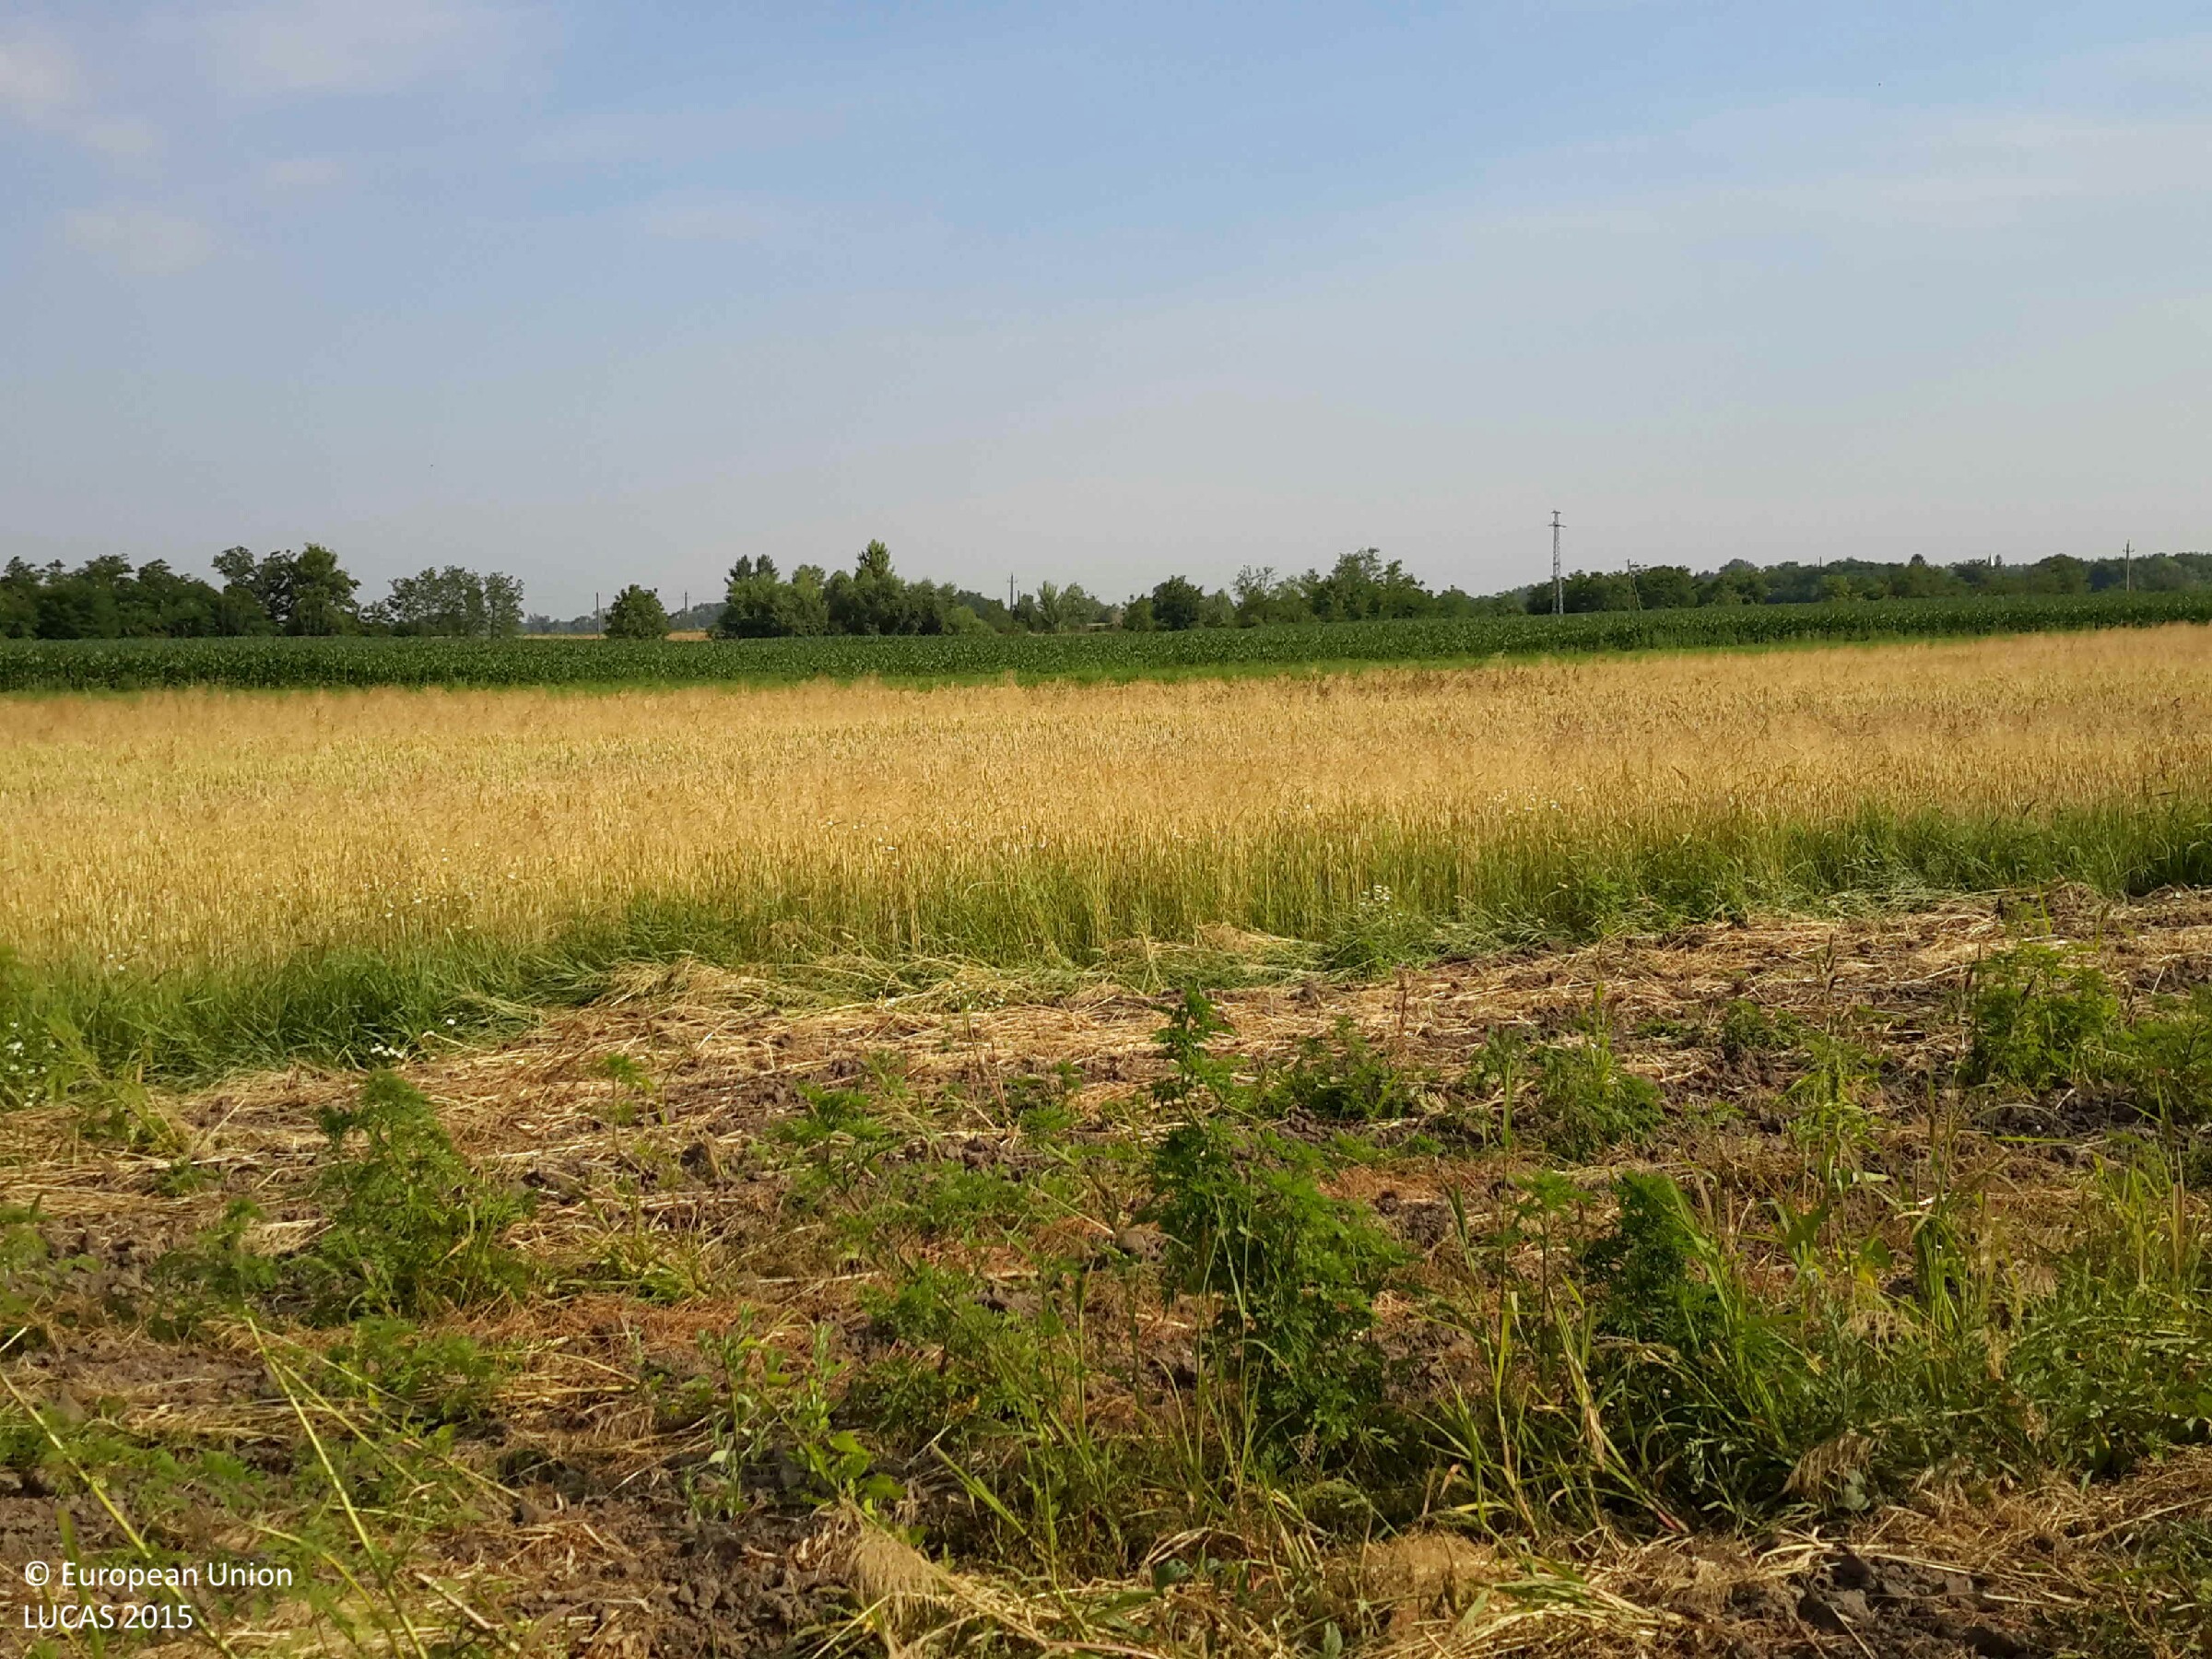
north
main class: Grassland
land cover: Spontaneously vegetated surfaces
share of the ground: 50 - 75 %
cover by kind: herbaceous plants 60 %, unconsolidated bare surface 40 %
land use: Fallow land
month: July
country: HU
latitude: 47.3918
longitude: 17.4662
